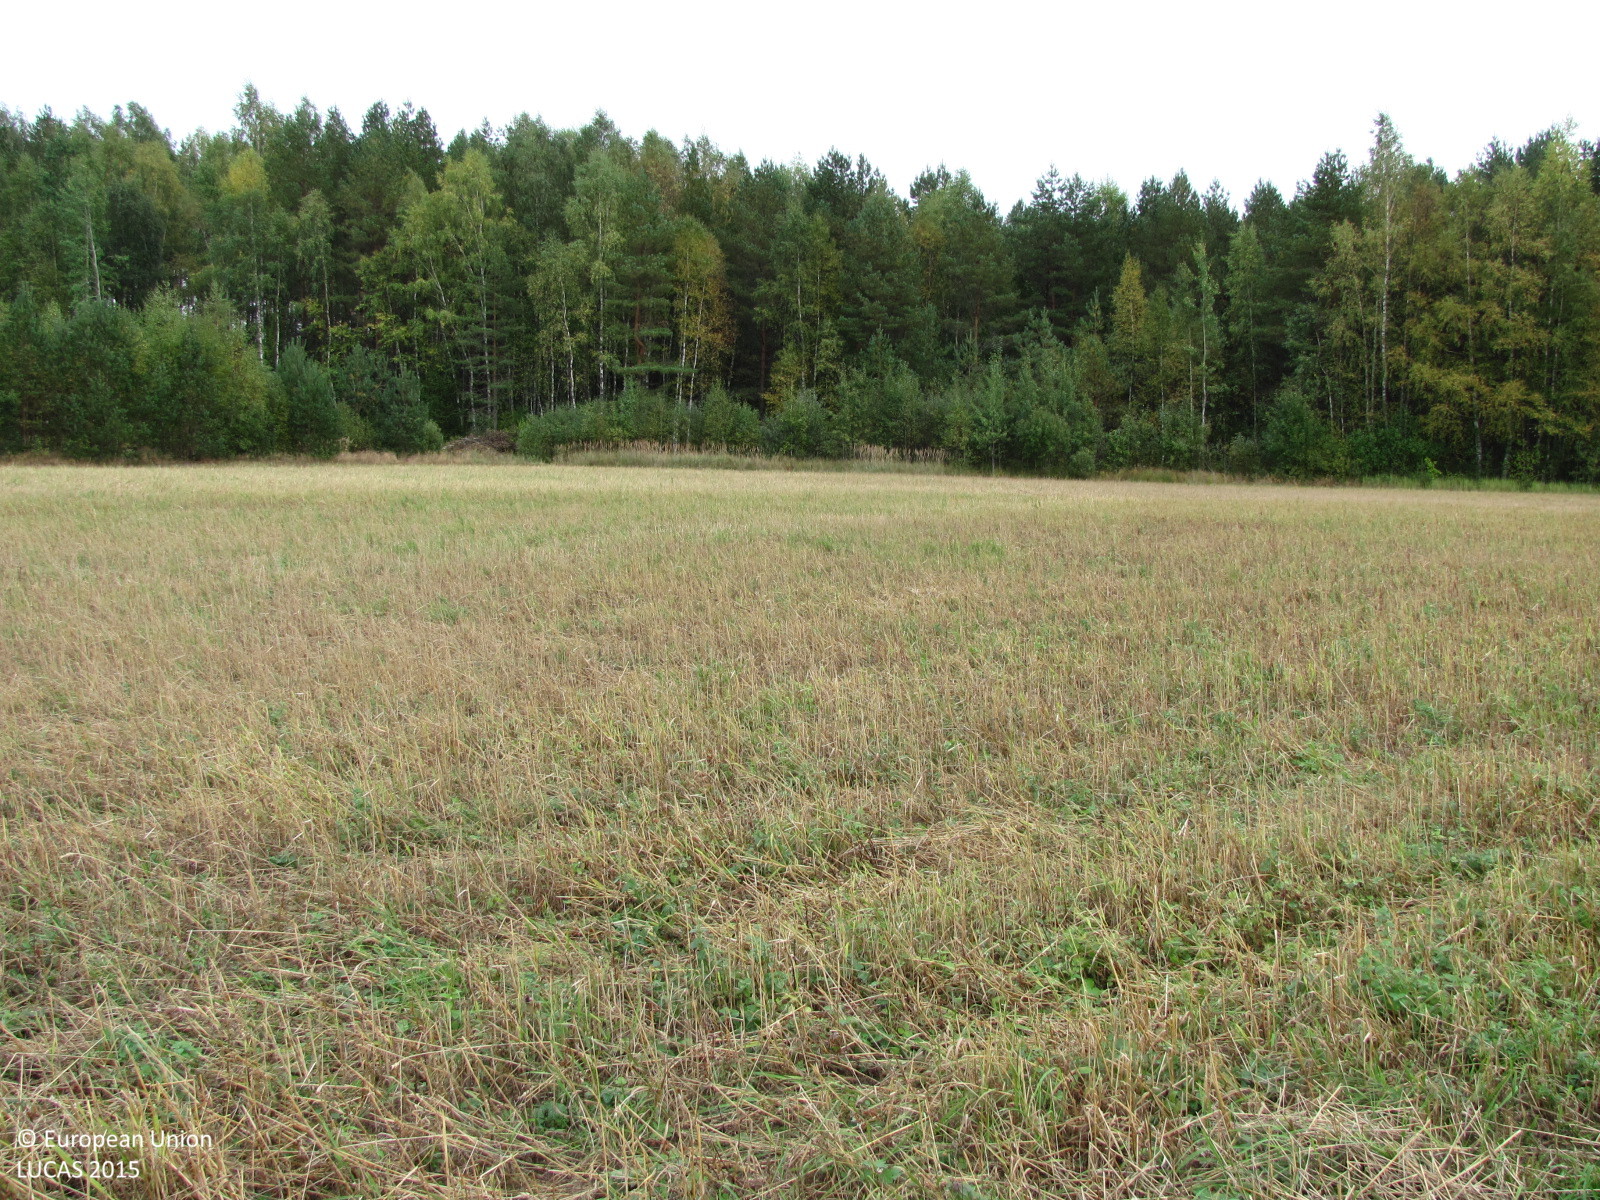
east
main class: Cropland
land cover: Common wheat
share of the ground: 50 - 75 %
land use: Agriculture (excluding fallow land and kitchen gardens)
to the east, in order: Common wheat; Tracks; Abandoned hedges; Ditches and canals; Pine dominated mixed woodland
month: September
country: LV
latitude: 57.1249
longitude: 24.5812
